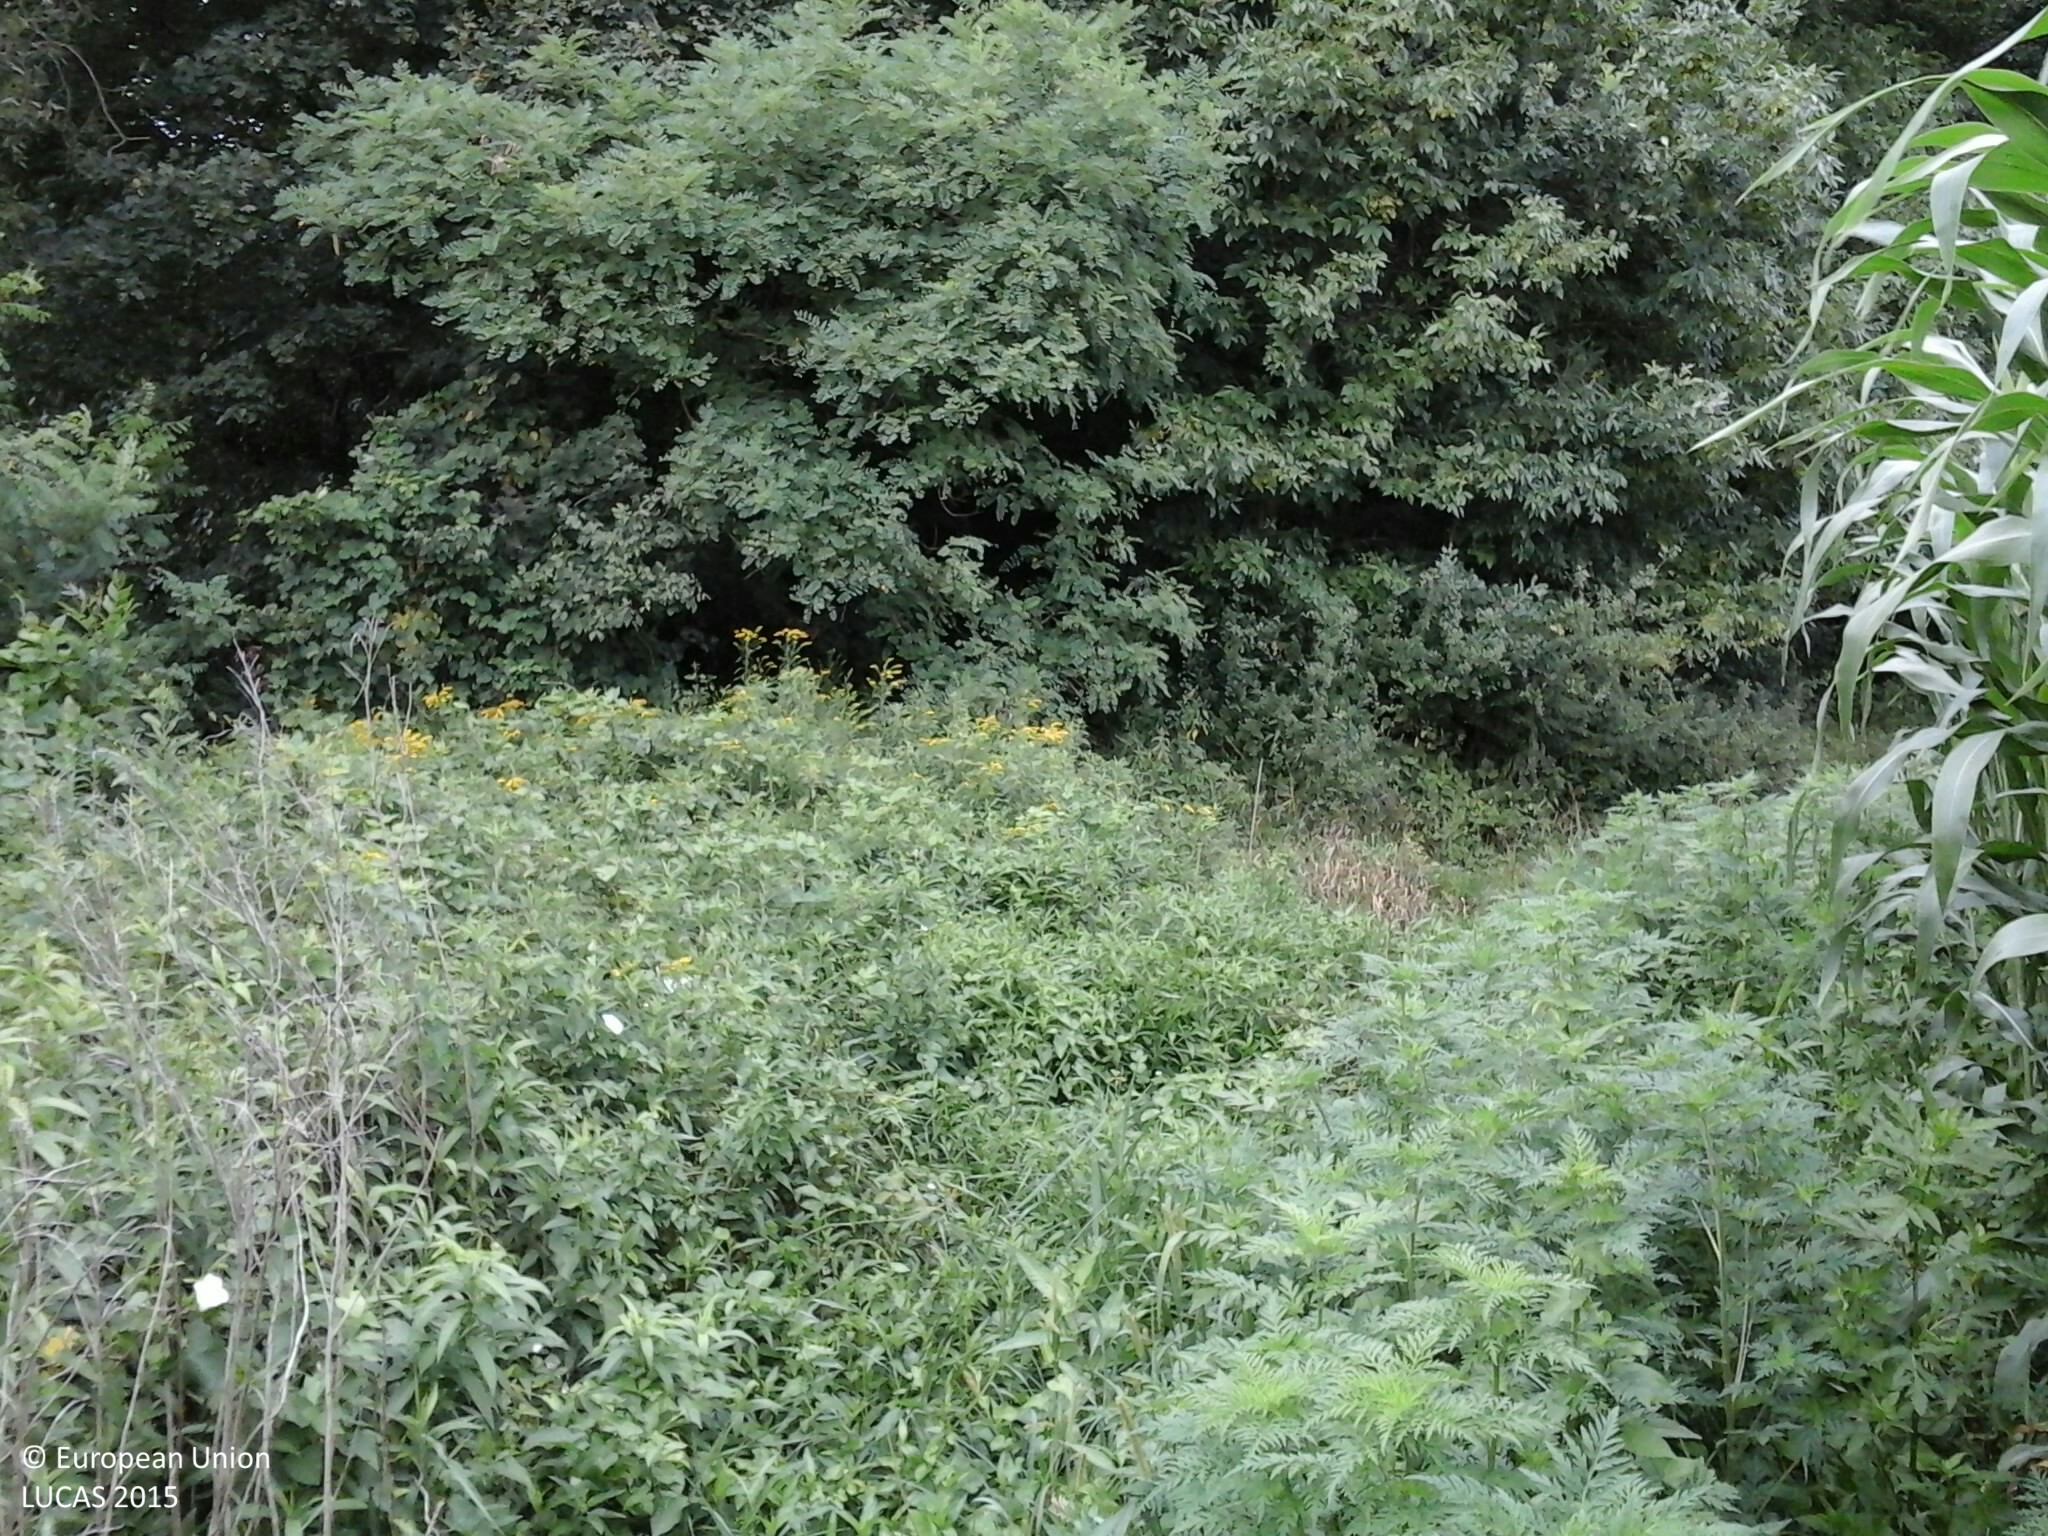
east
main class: Cropland
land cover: Other cereals
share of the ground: > 75 %
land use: Agriculture (excluding fallow land and kitchen gardens)
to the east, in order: Other cereals; Broadleaved woodland; Other cereals
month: July
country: HU
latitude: 46.6626
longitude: 16.4445
